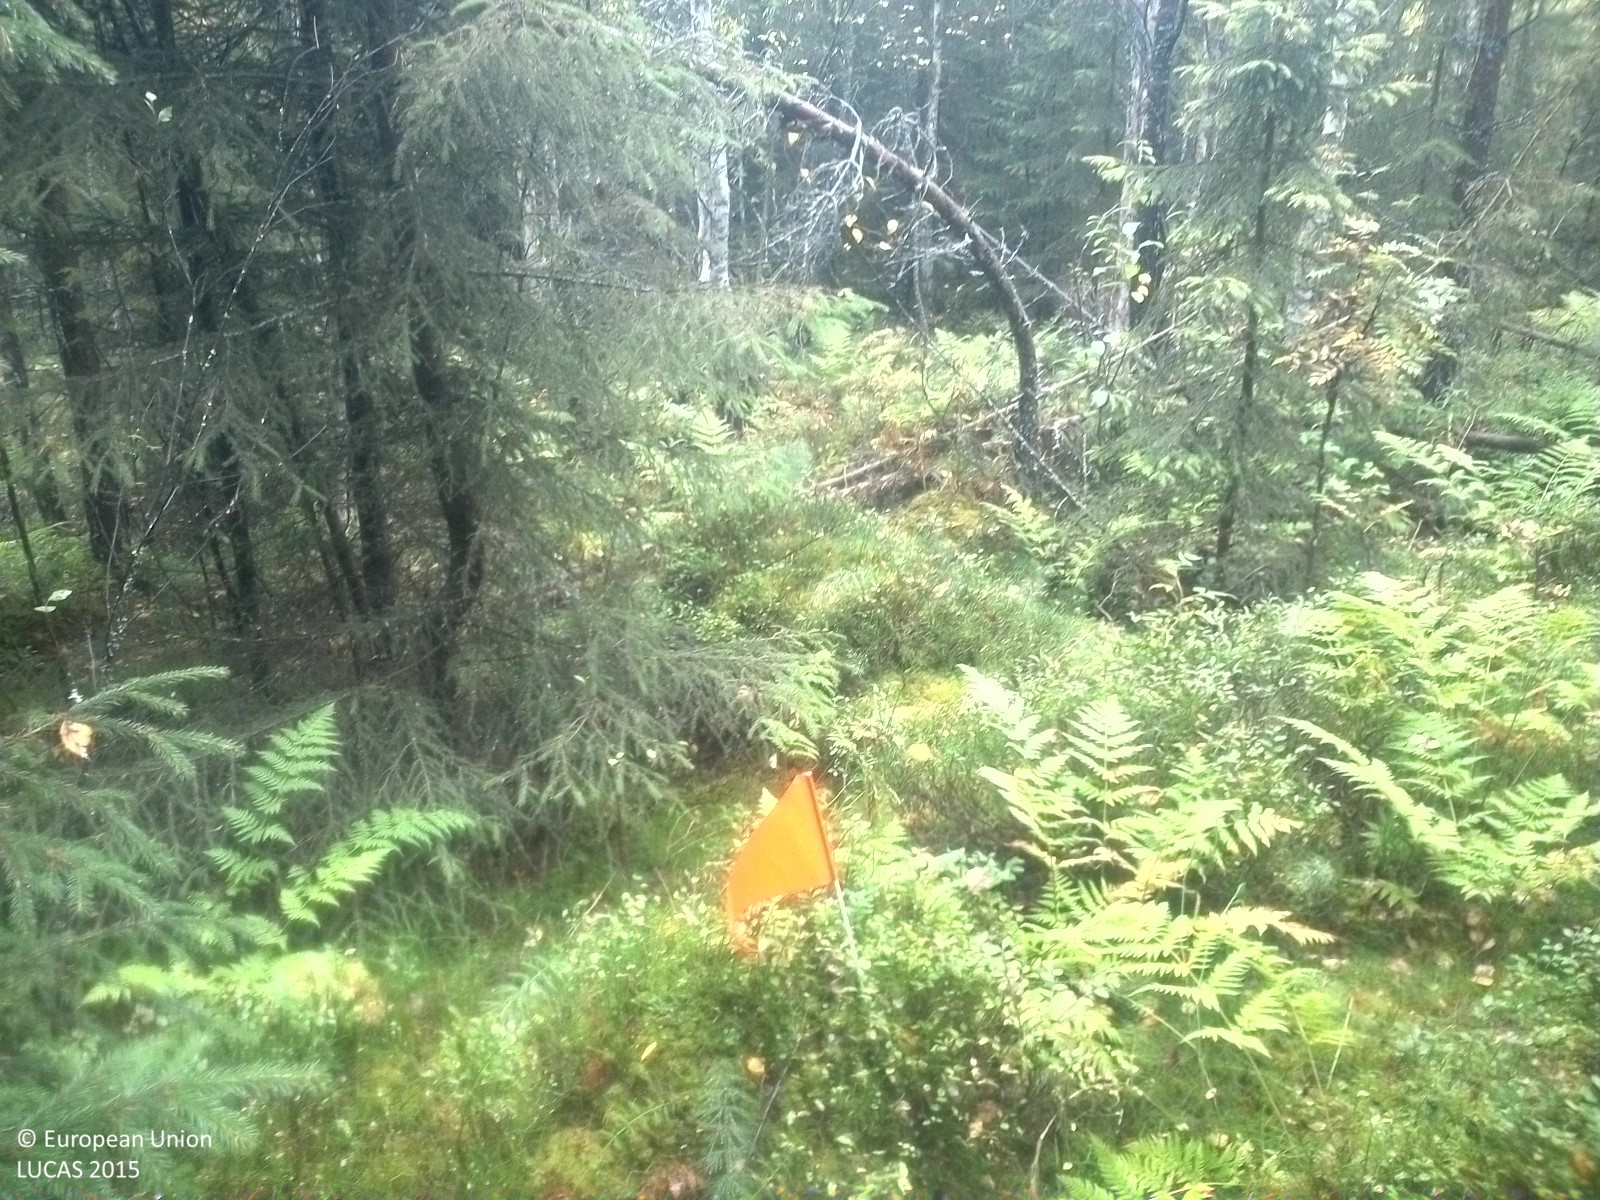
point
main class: Woodland
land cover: Other mixed woodland
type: boreal forest
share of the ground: 50 - 75 %
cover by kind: coniferous forest trees 40 %, lichens and mosses 20 %, broadleaved forest trees 15 %, herbaceous plants 15 %, shrubs 10 %
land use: Forestry
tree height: > 5 m
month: September
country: SE
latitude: 62.1301
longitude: 15.5614
